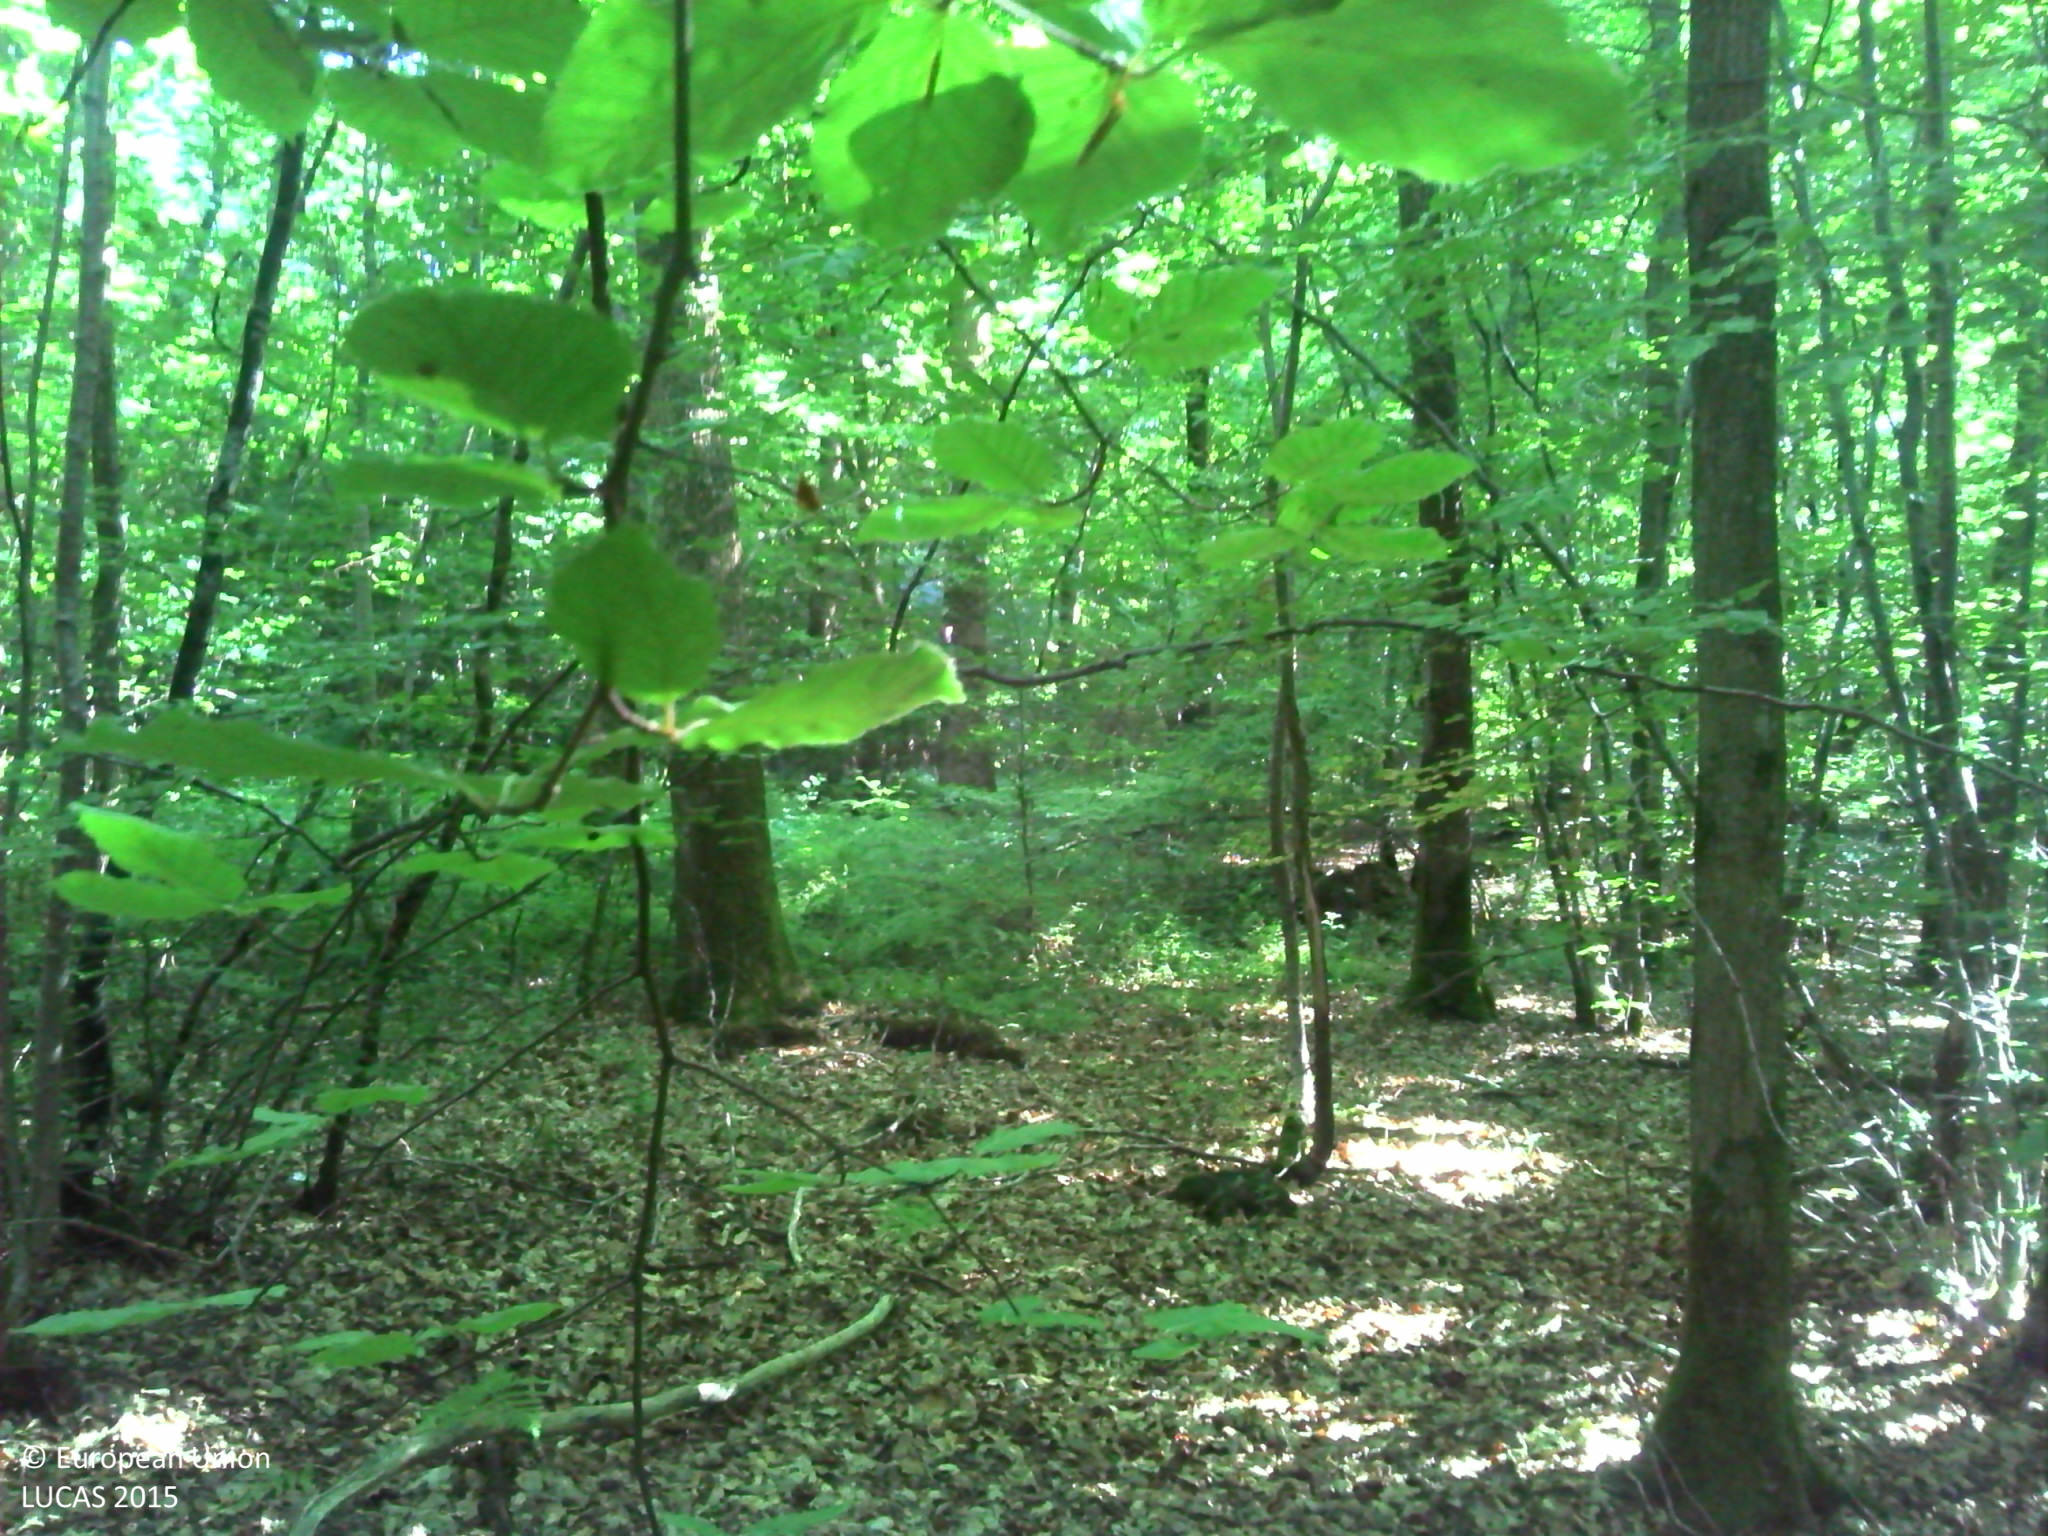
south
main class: Woodland
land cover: Broadleaved woodland
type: acidophilous oak and oak-birch forest
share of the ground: > 75 %
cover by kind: broadleaved forest trees 70 %, herbaceous plants 15 %, consolidated bare surface 15 %
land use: Forestry
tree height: > 5 m
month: July
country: FR
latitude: 49.0620
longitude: 0.7105
